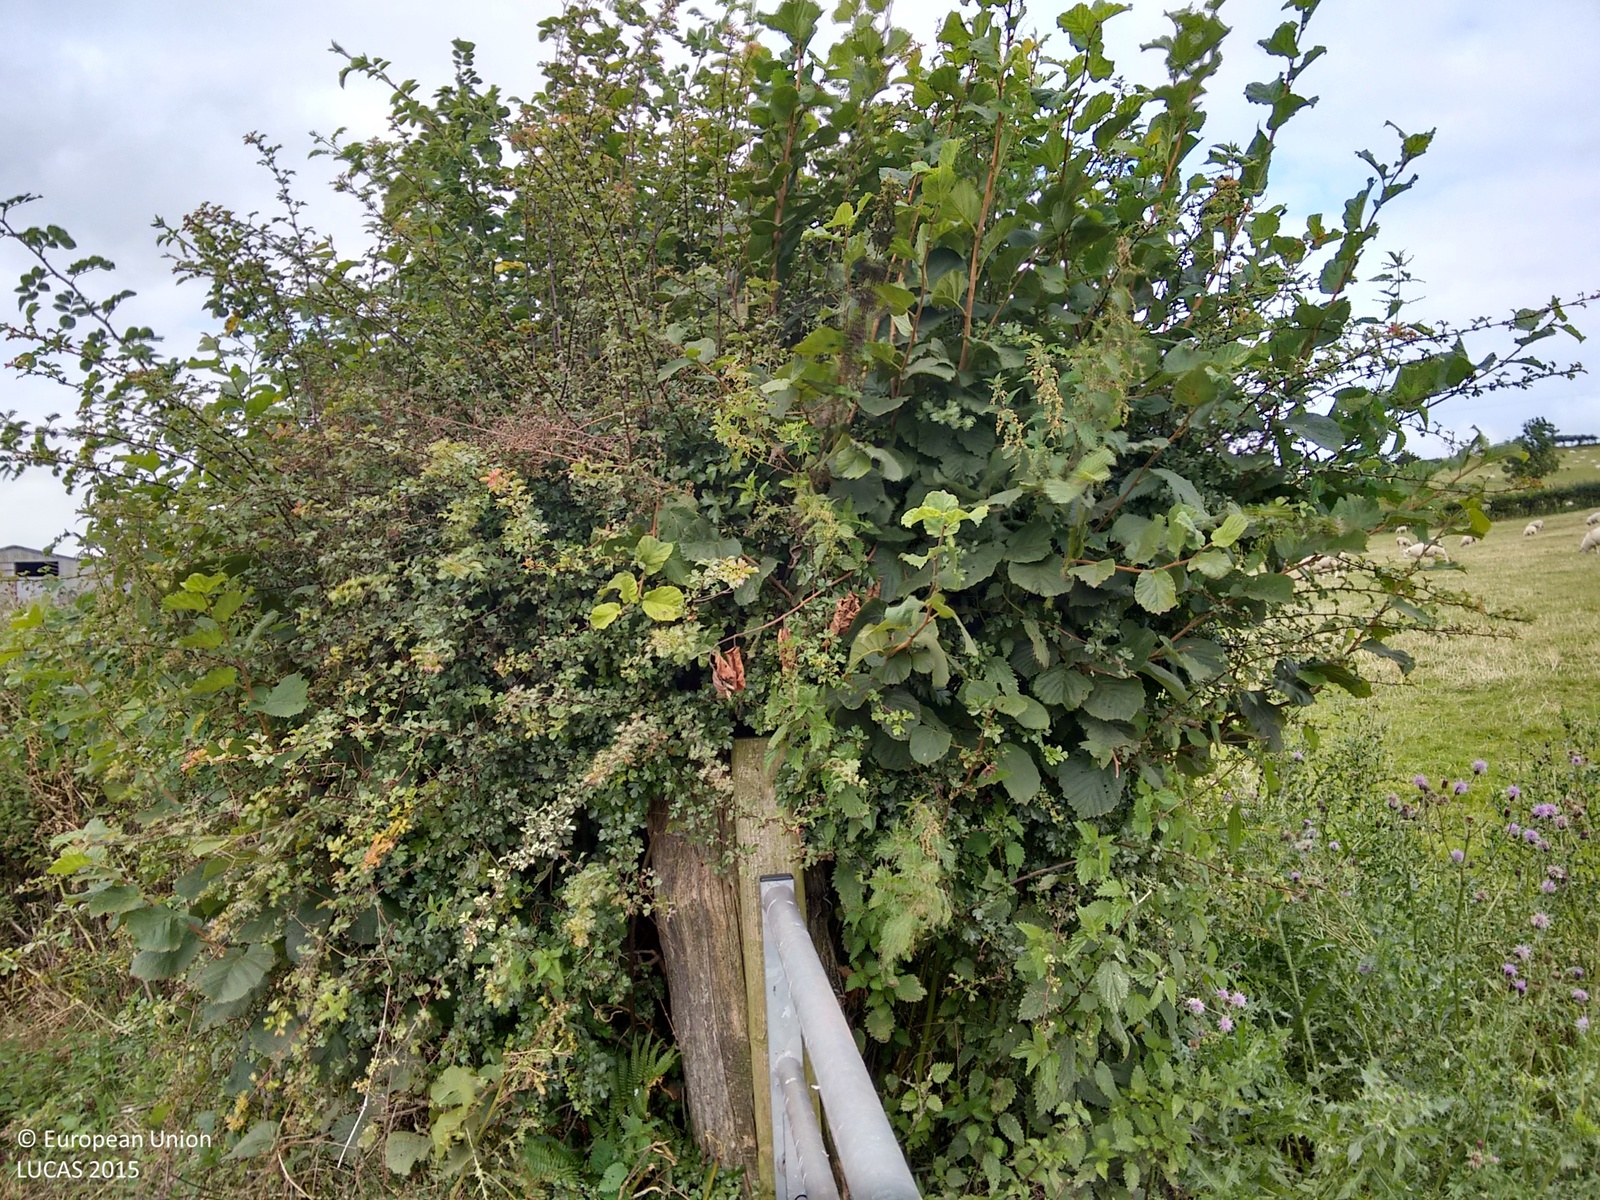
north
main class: Grassland
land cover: Grassland without tree/shrub cover
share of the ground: > 75 %
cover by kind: herbaceous plants 100 %
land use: Agriculture (excluding fallow land and kitchen gardens)
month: September
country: GB
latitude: 52.0623
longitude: -3.4592
